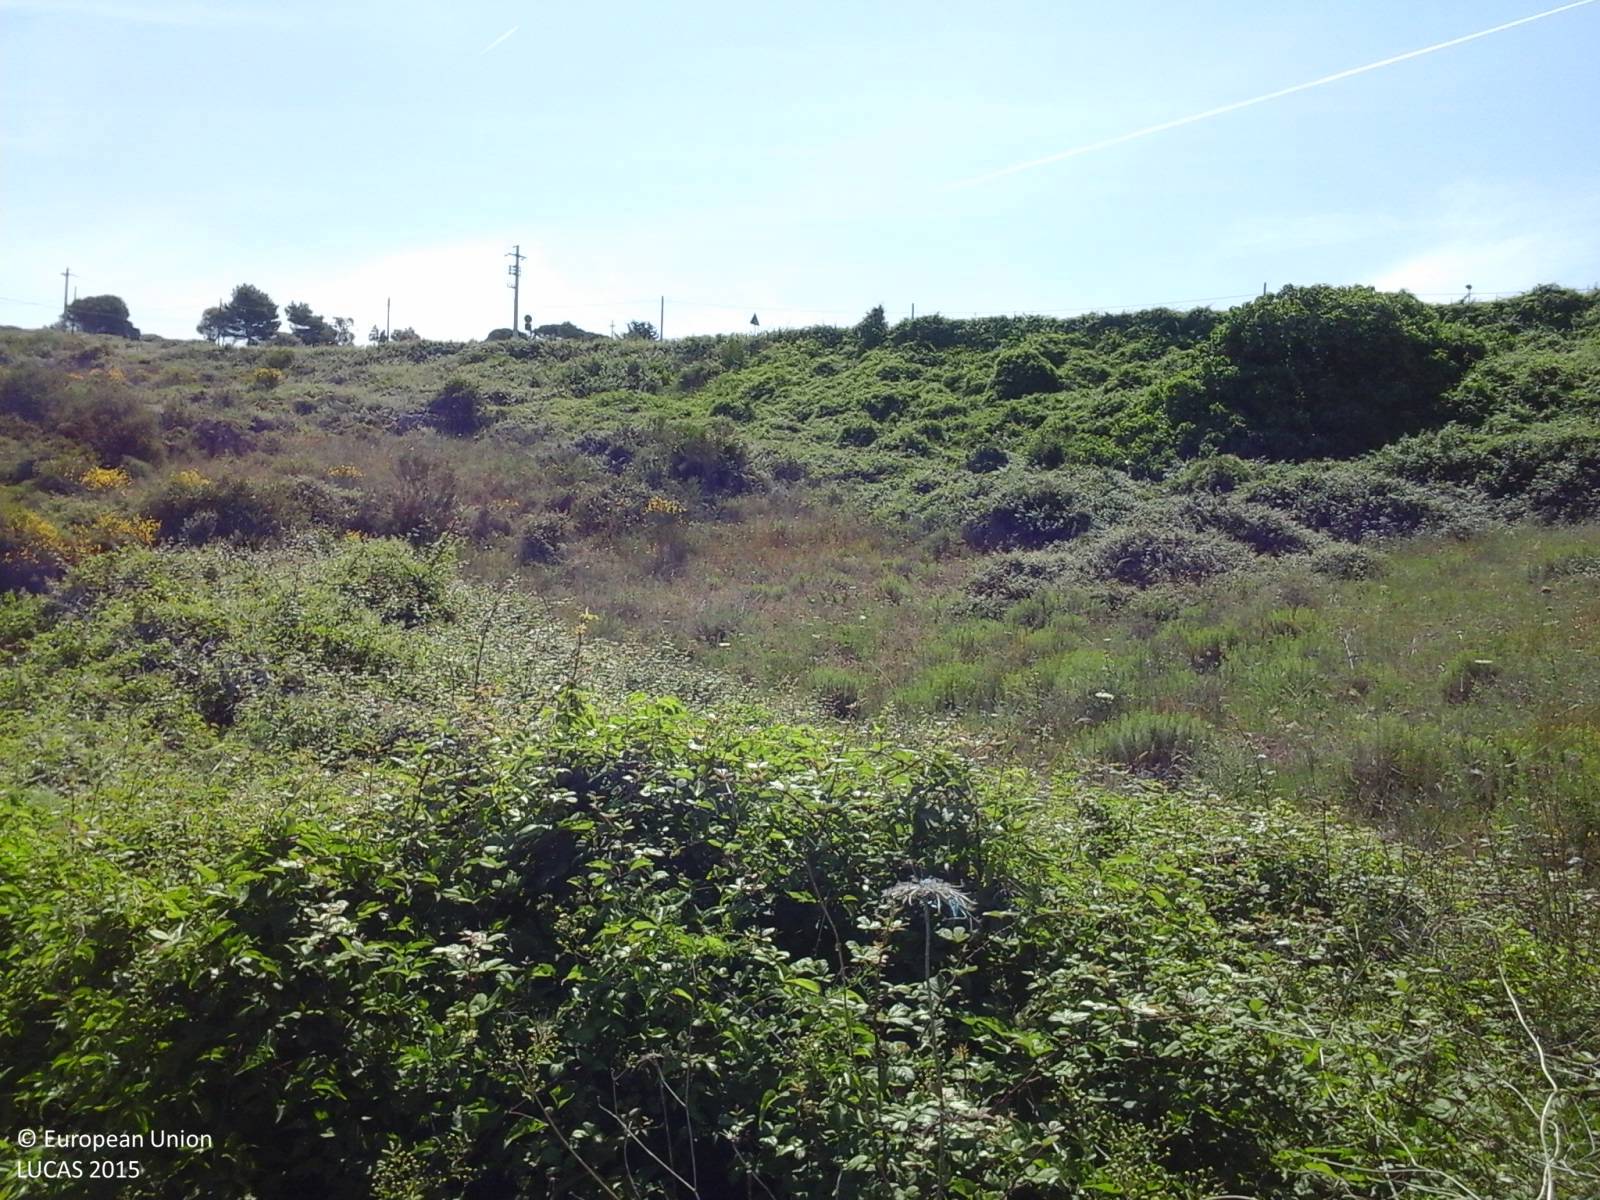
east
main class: Shrubland
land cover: Shrubland without tree cover
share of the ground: > 75 %
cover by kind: herbaceous plants 55 %, shrubs 45 %
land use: Semi-natural and natural areas not in use
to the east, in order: Shrubland without tree cover; Dry stone walls; Grass margins; Paved roads, cycling and walking lanes; Grassland without tree/shrub cover; Electric lines; Paved roads, cycling and walking lanes; Abandoned hedges; Dry stone walls; Grassland without tree/shrub cover; Electric lines; Dry stone walls; Grass margins; Paved roads, cycling and walking lanes
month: May
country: IT
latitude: 40.7822
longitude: 8.5966
